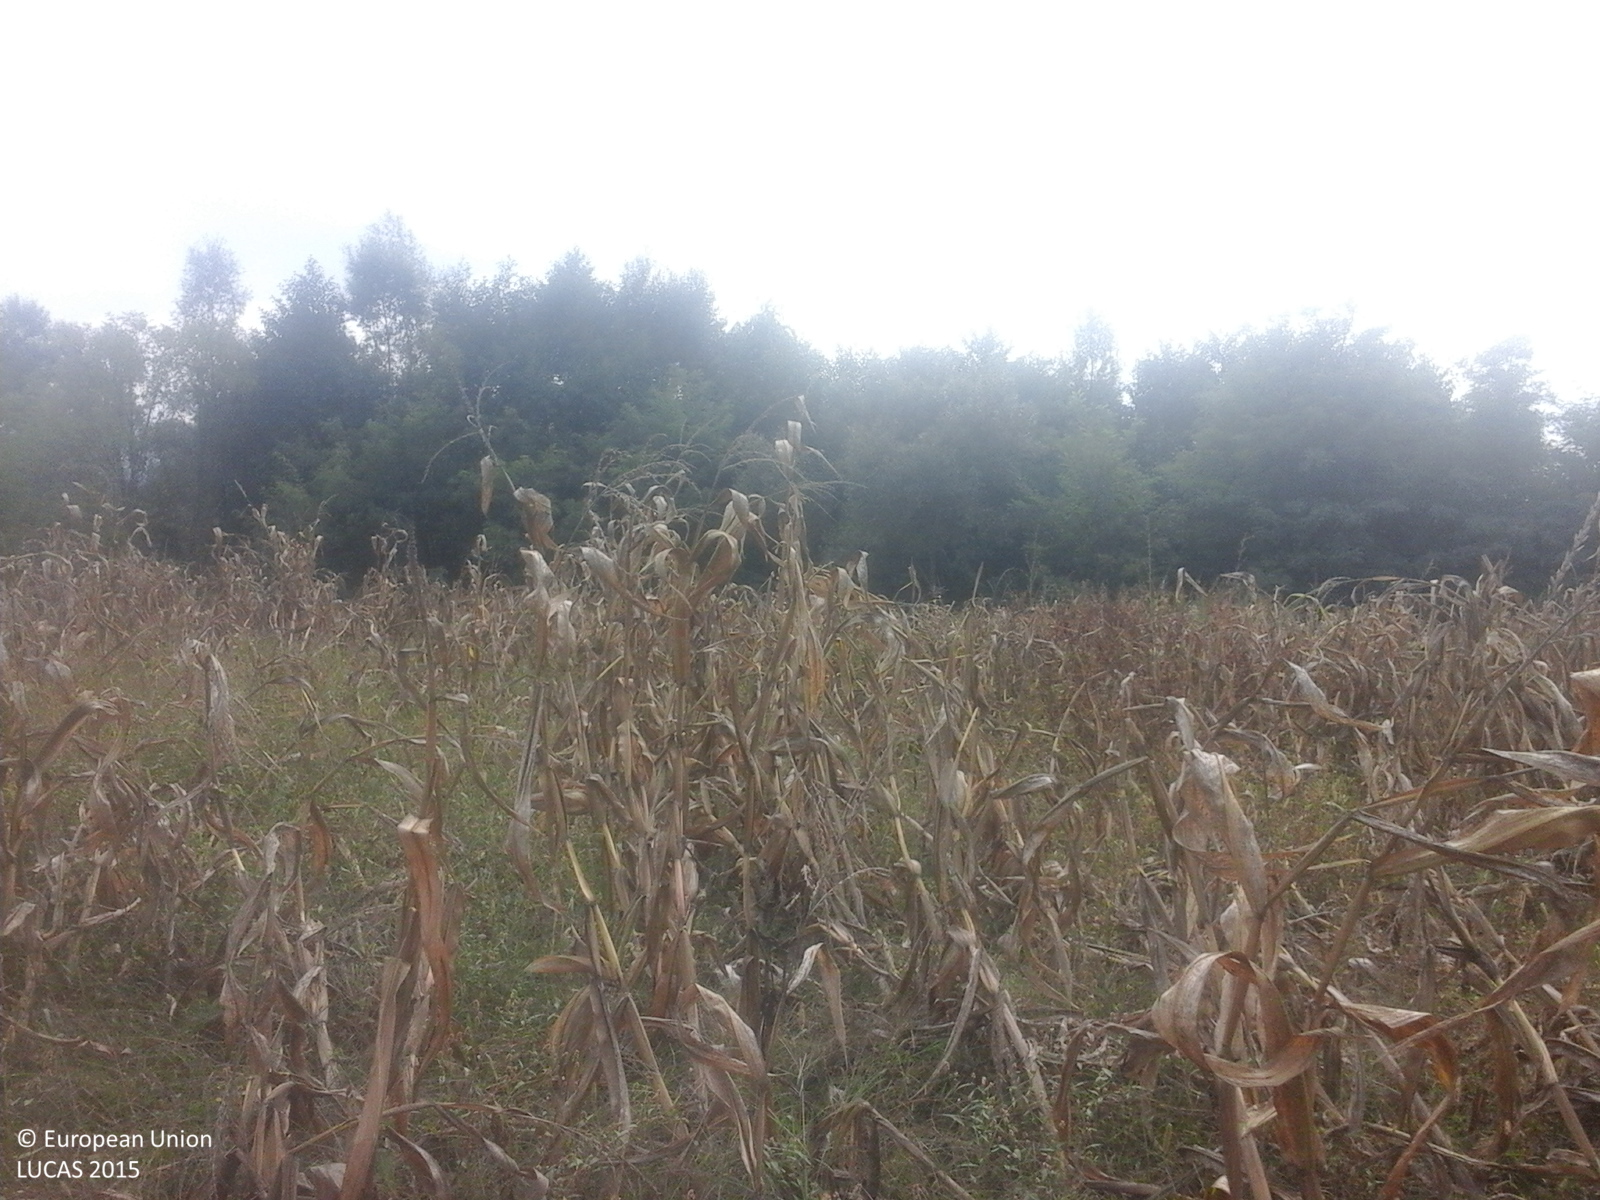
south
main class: Cropland
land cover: Maize
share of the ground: > 75 %
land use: Agriculture (excluding fallow land and kitchen gardens)
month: September
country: RO
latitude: 45.8665
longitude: 22.2167
